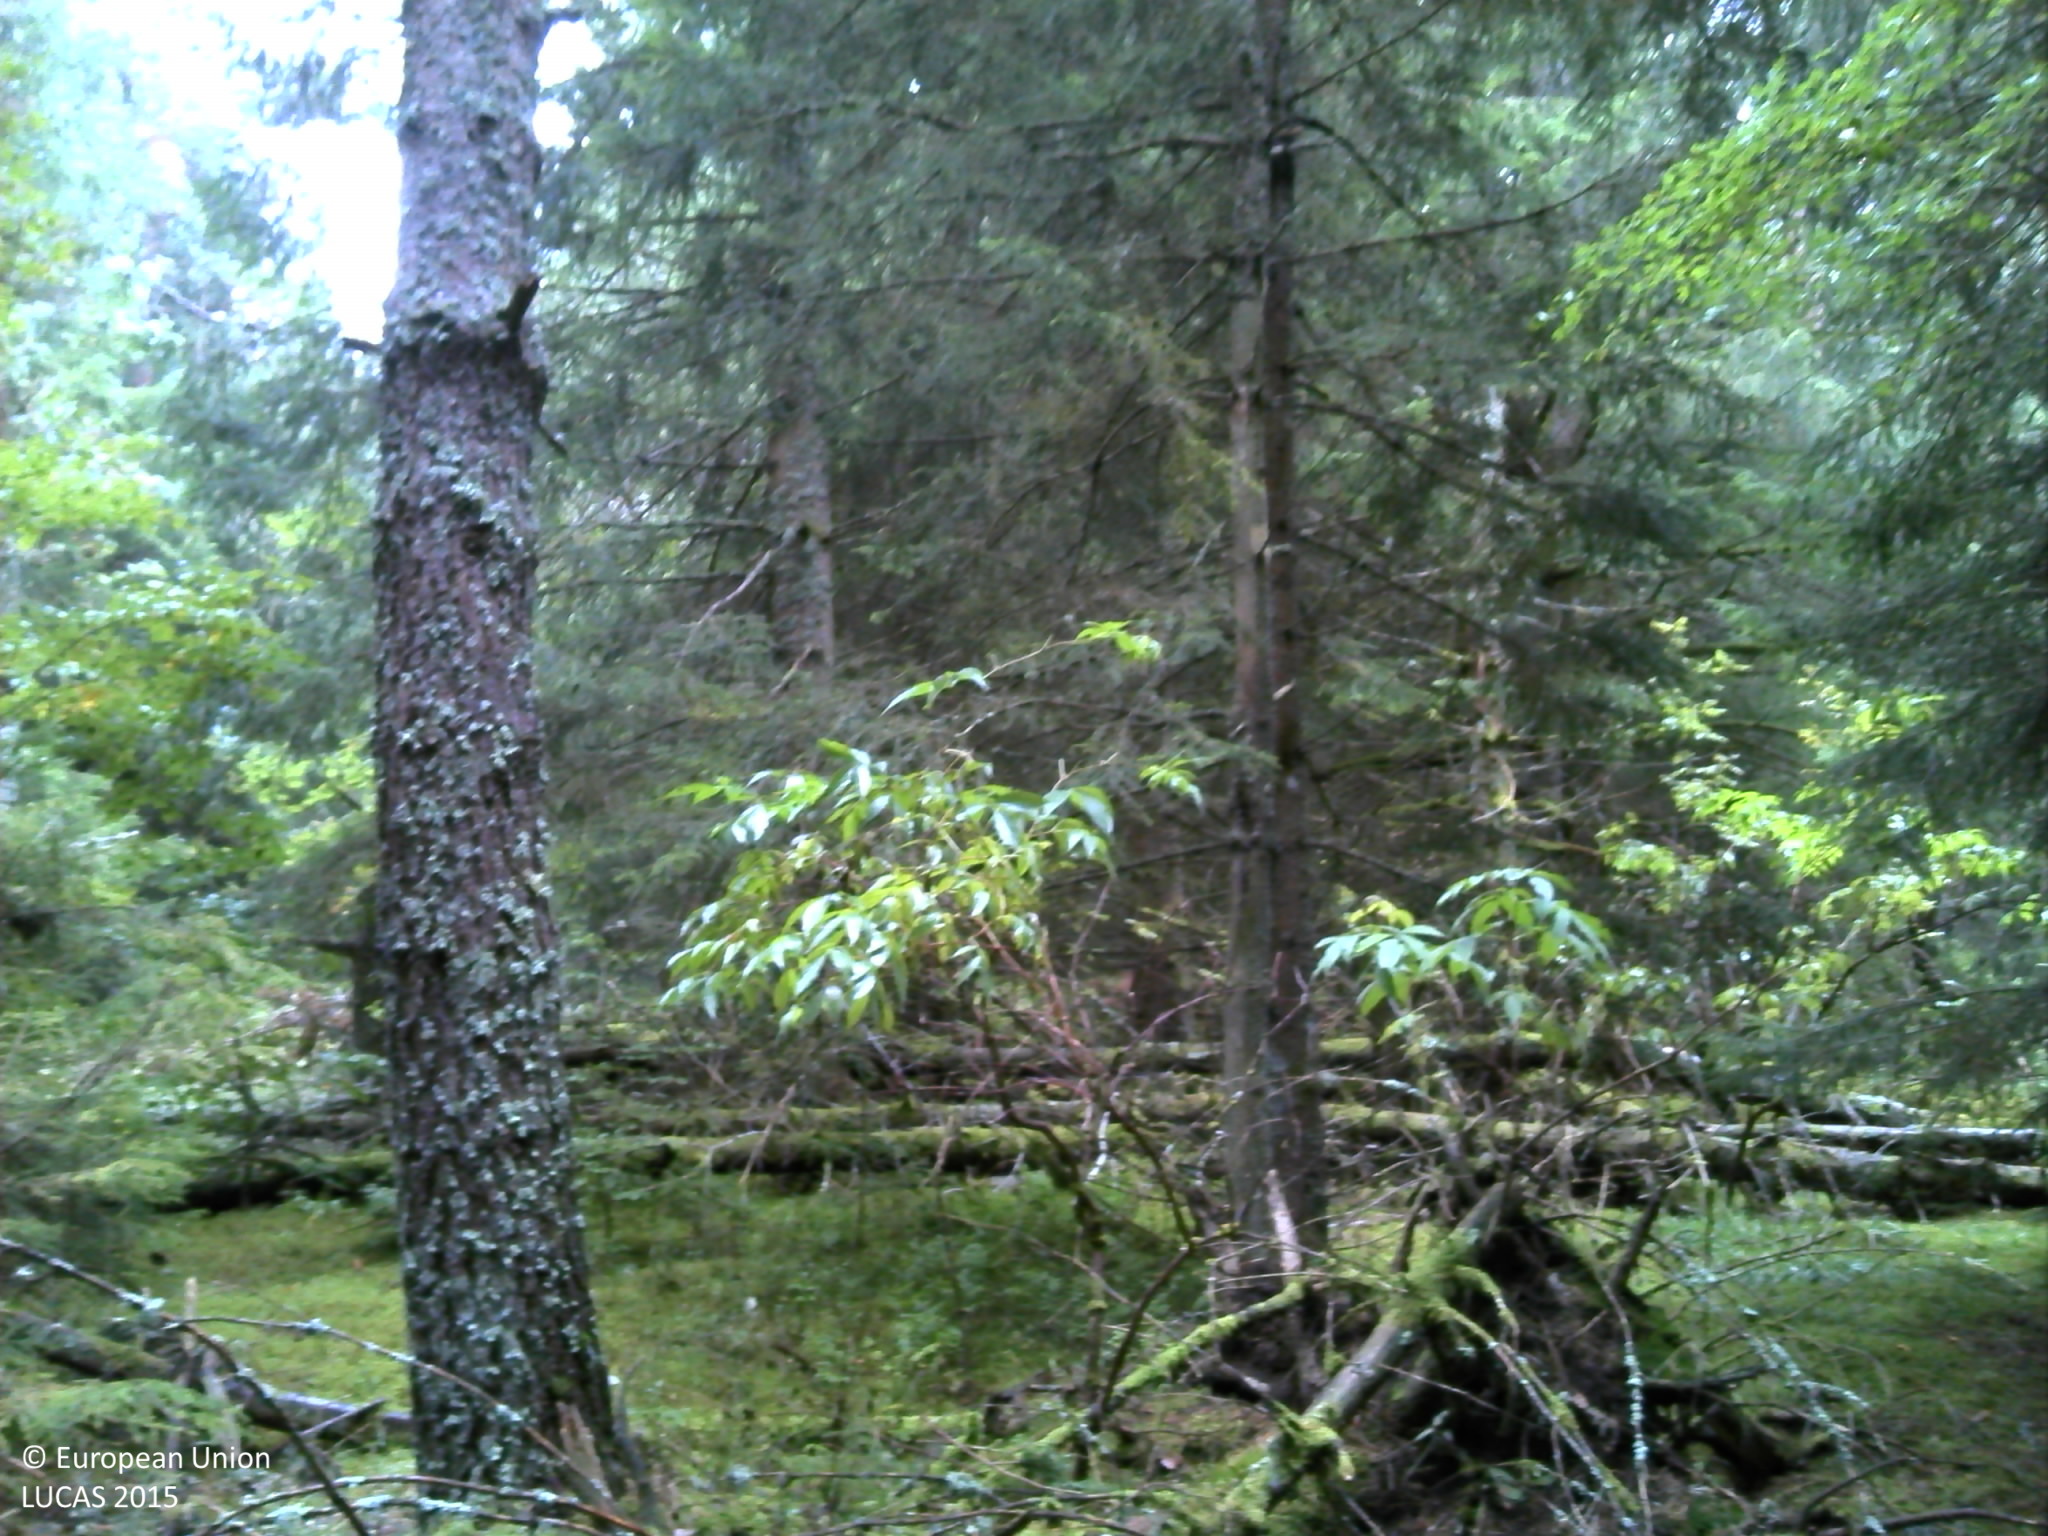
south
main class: Woodland
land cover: Spruce dominated coniferous woodland
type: alpine coniferous forest
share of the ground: > 75 %
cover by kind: coniferous forest trees 75 %, lichens and mosses 25 %
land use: Forestry
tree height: > 5 m
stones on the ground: < 10 %
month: September
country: FR
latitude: 45.6436
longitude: 2.8786
